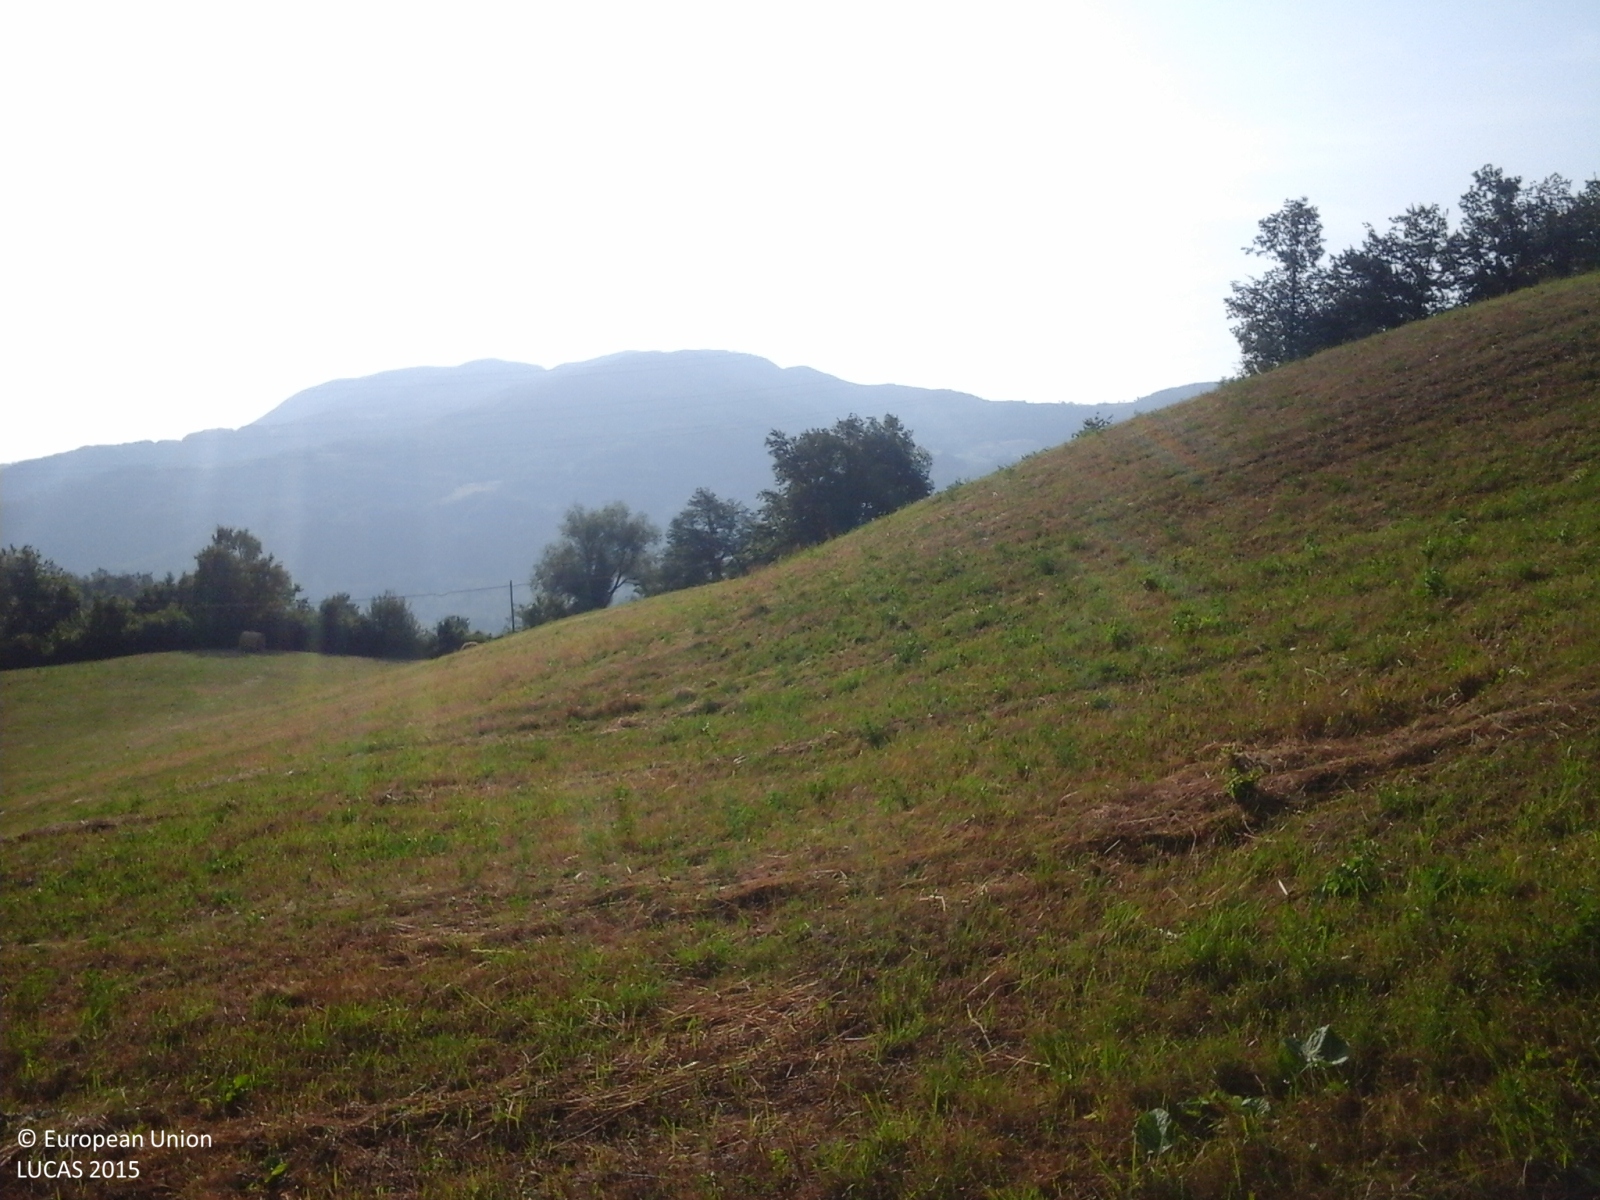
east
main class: Cropland
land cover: Lucerne
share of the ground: > 75 %
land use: Agriculture (excluding fallow land and kitchen gardens)
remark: Harvested field
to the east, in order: Lucerne; Electric lines; Lucerne; Managed hedges; Paved roads, cycling and walking lanes; Grass margins; Fences; Broadleaved woodland
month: July
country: IT
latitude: 44.4225
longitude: 10.2130
